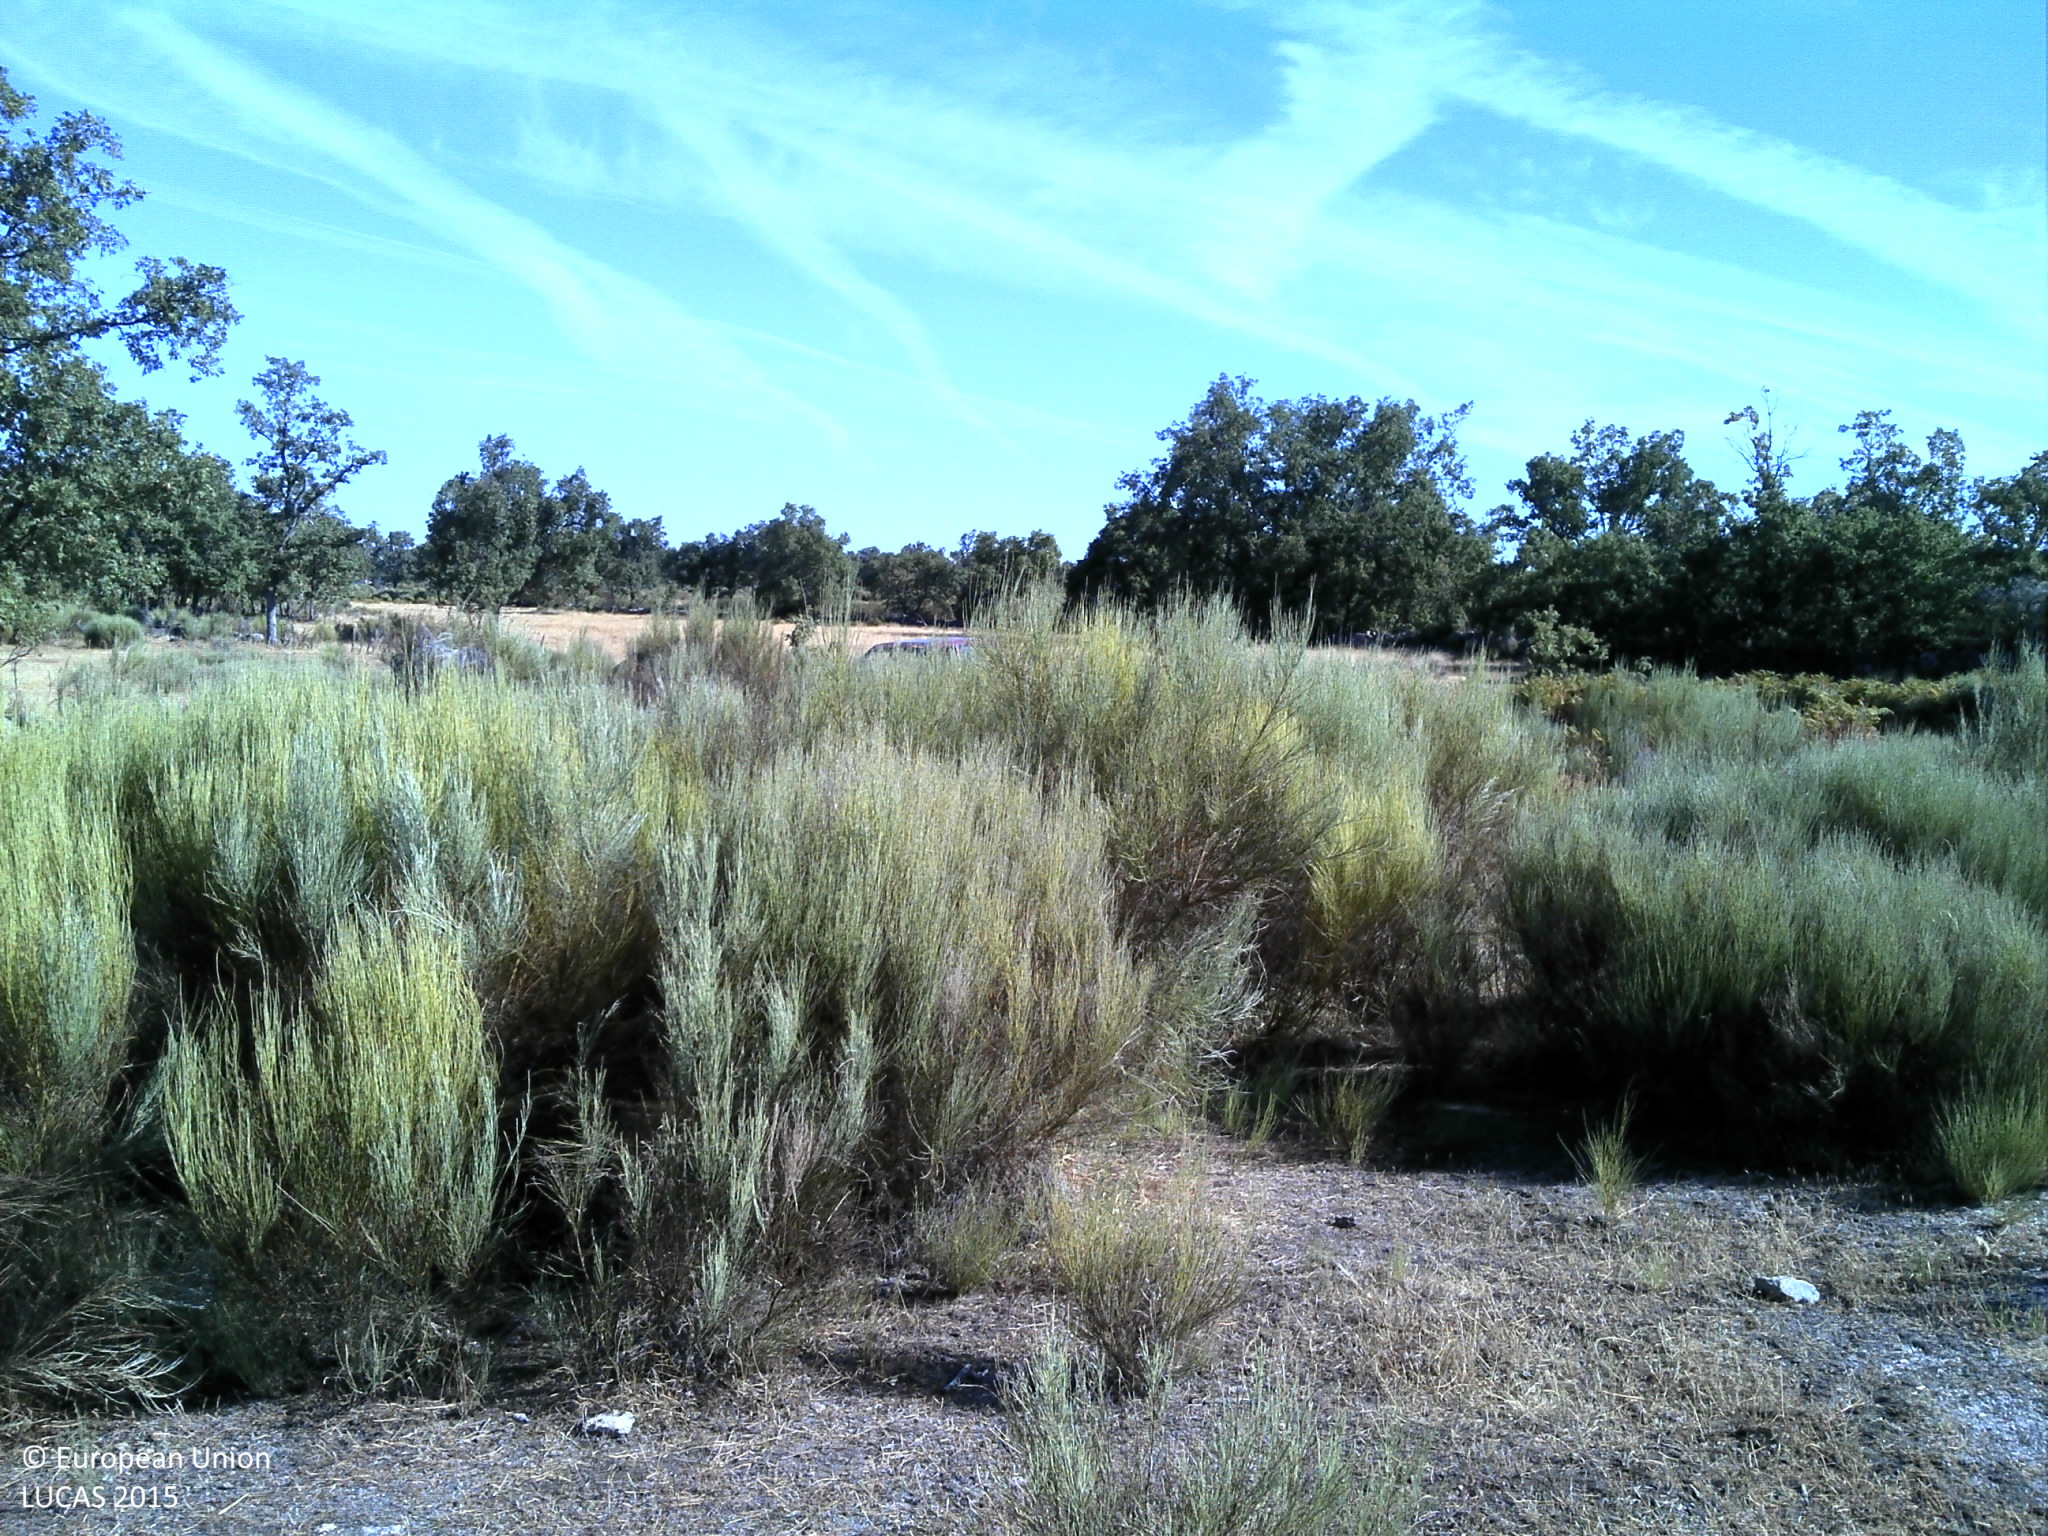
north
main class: Shrubland
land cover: Shrubland without tree cover
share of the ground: 50 - 75 %
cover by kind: shrubs 50 %, herbaceous plants 30 %, consolidated bare surface 20 %
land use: Agriculture (excluding fallow land and kitchen gardens)
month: August
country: PT
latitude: 39.4350
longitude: -7.4127
